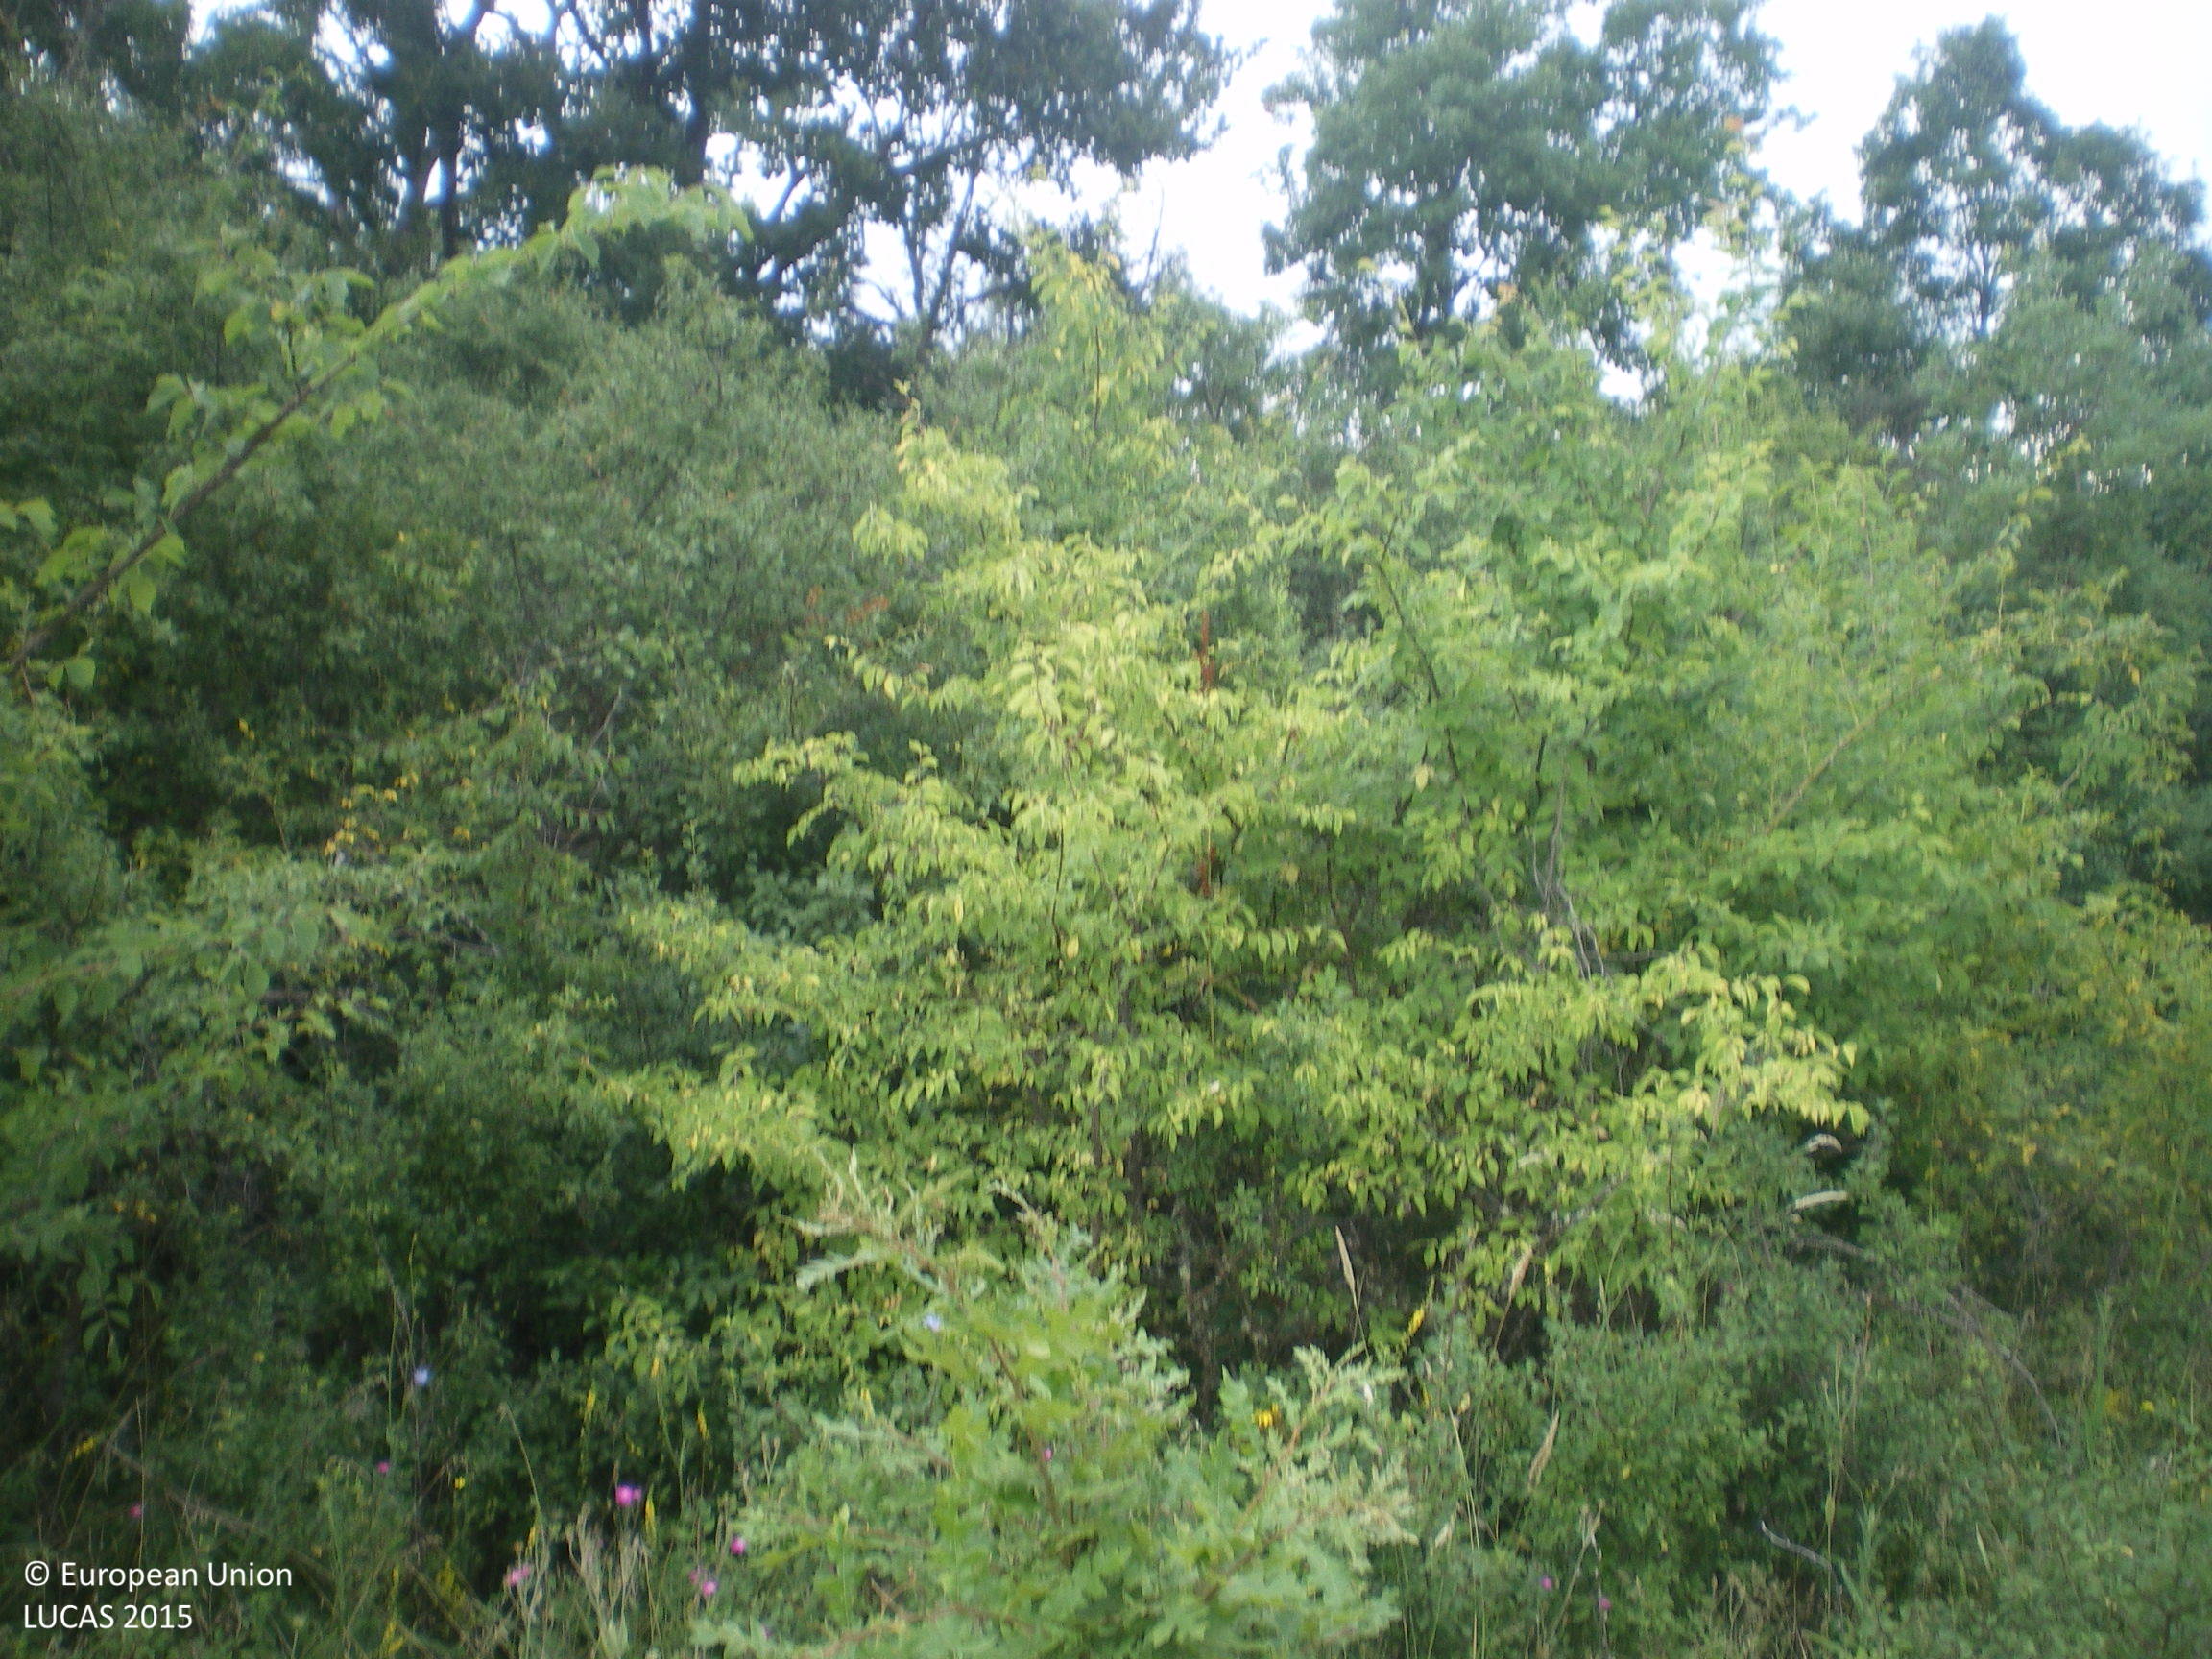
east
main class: Woodland
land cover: Broadleaved woodland
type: mesophytic deciduous forest
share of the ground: 50 - 75 %
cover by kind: broadleaved forest trees 50 %, herbaceous plants 30 %, shrubs 20 %
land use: Forestry
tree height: > 5 m
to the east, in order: Broadleaved woodland; Shrubland with sparse tree cover; Grassland without tree/shrub cover; Shrubland with sparse tree cover
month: July
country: BG
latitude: 42.4173
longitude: 25.1929
